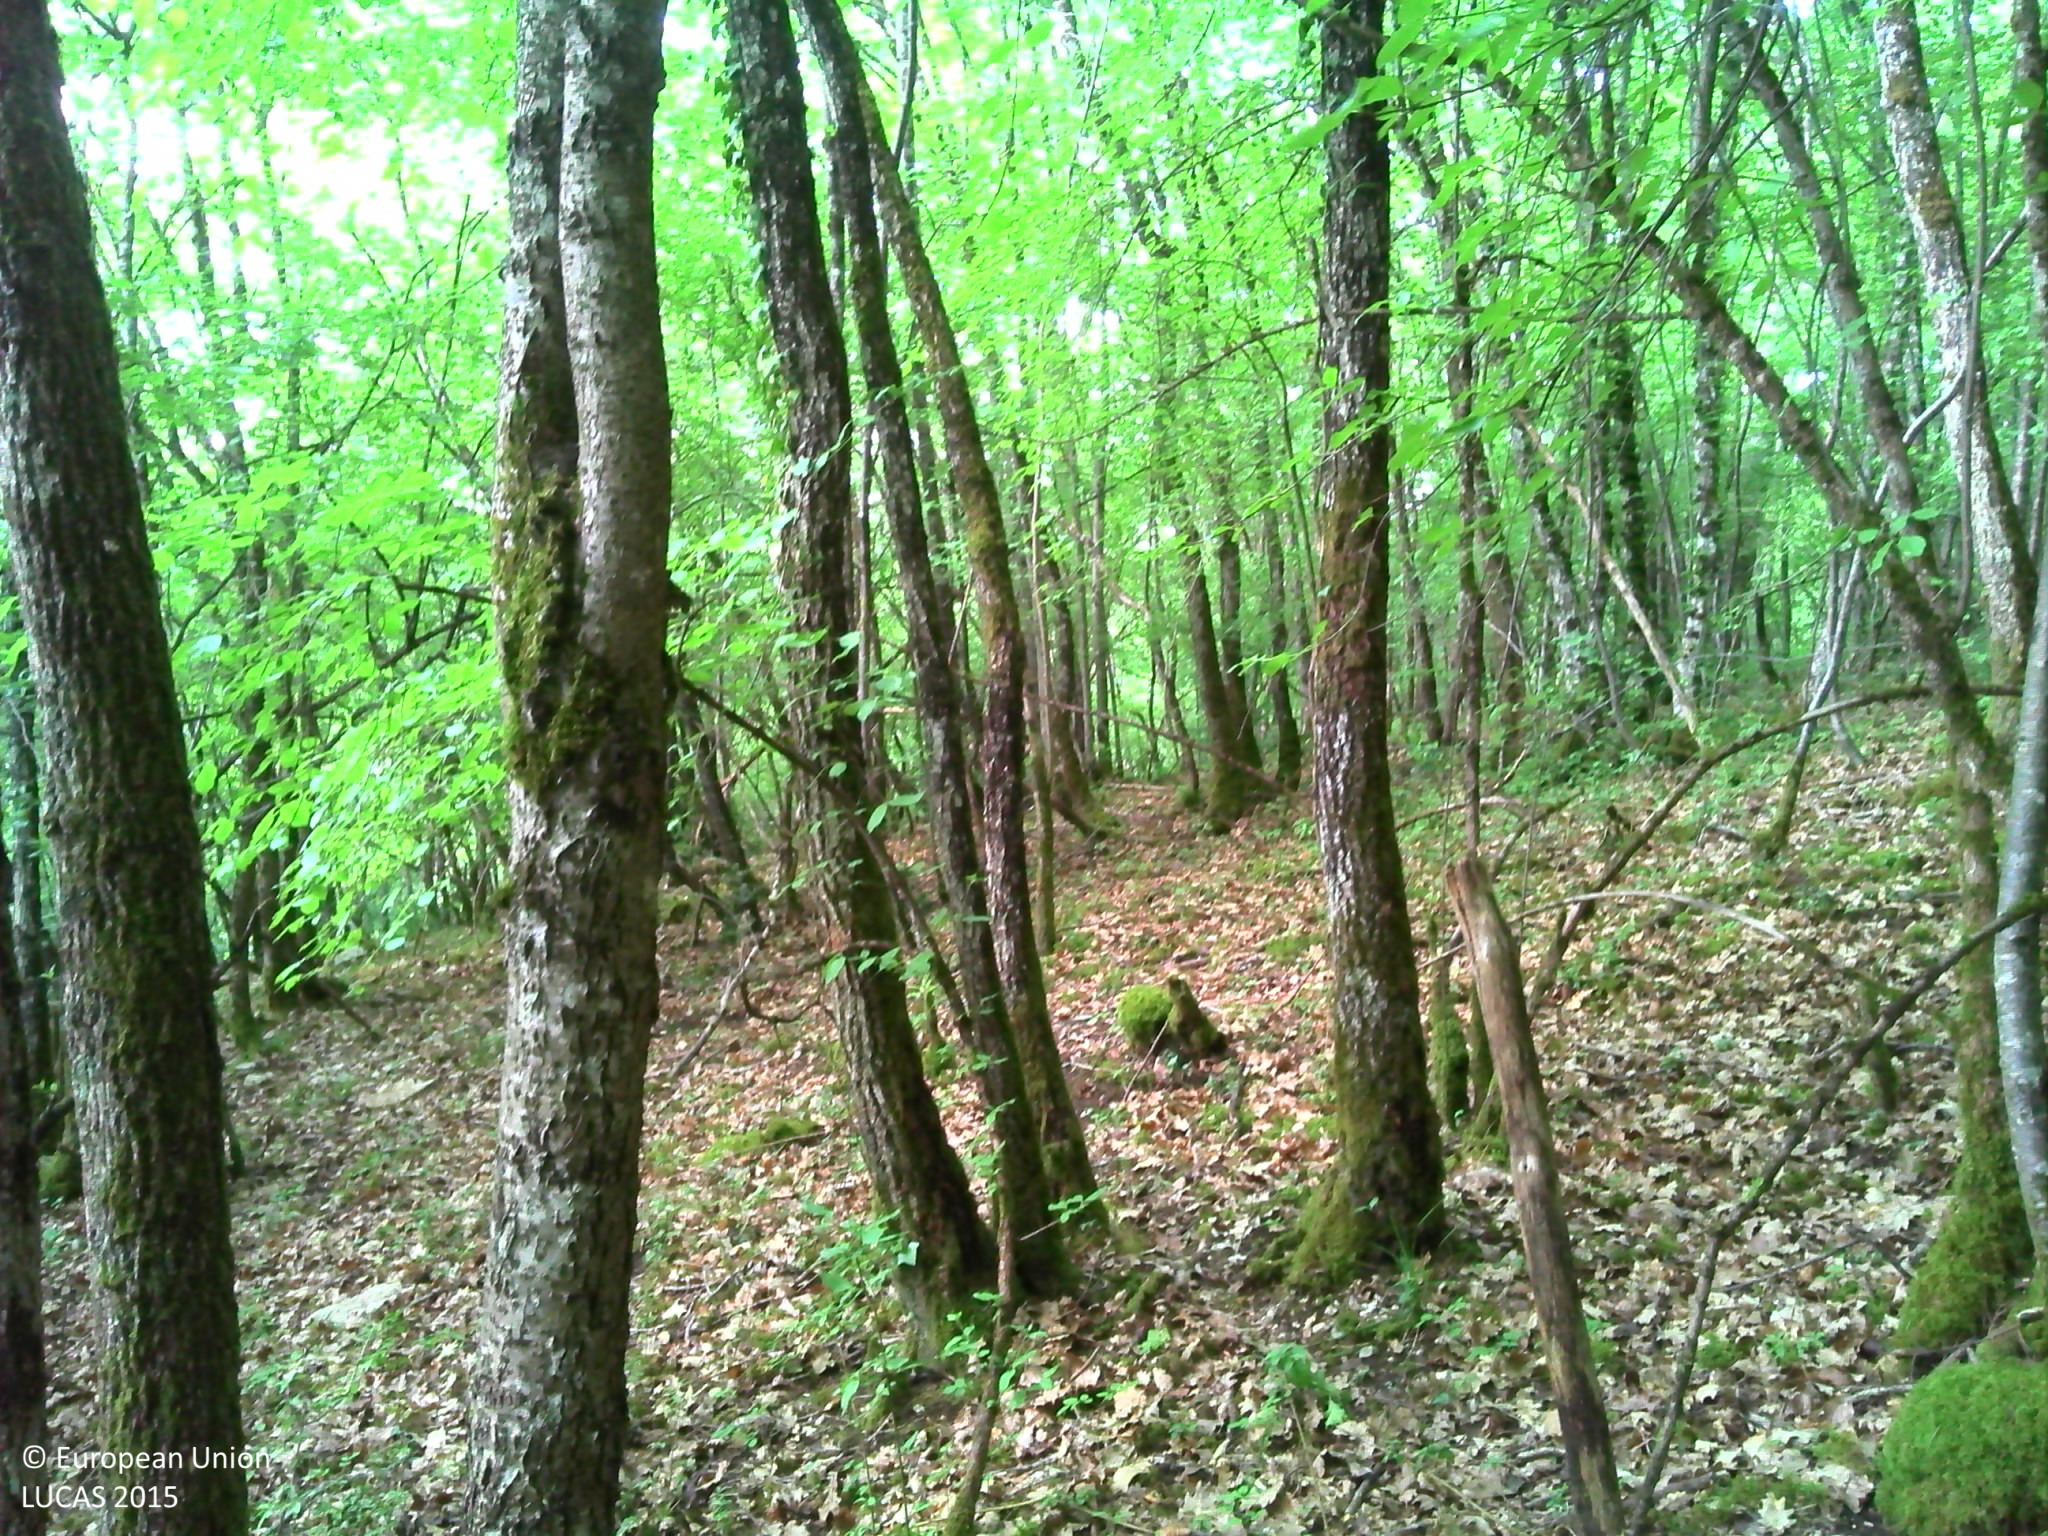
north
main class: Woodland
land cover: Pine dominated mixed woodland
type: mesophytic deciduous forest
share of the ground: > 75 %
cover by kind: broadleaved forest trees 55 %, coniferous forest trees 25 %, herbaceous plants 15 %, lichens and mosses 5 %
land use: Forestry
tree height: > 5 m
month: May
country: FR
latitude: 47.3137
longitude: 4.9338
